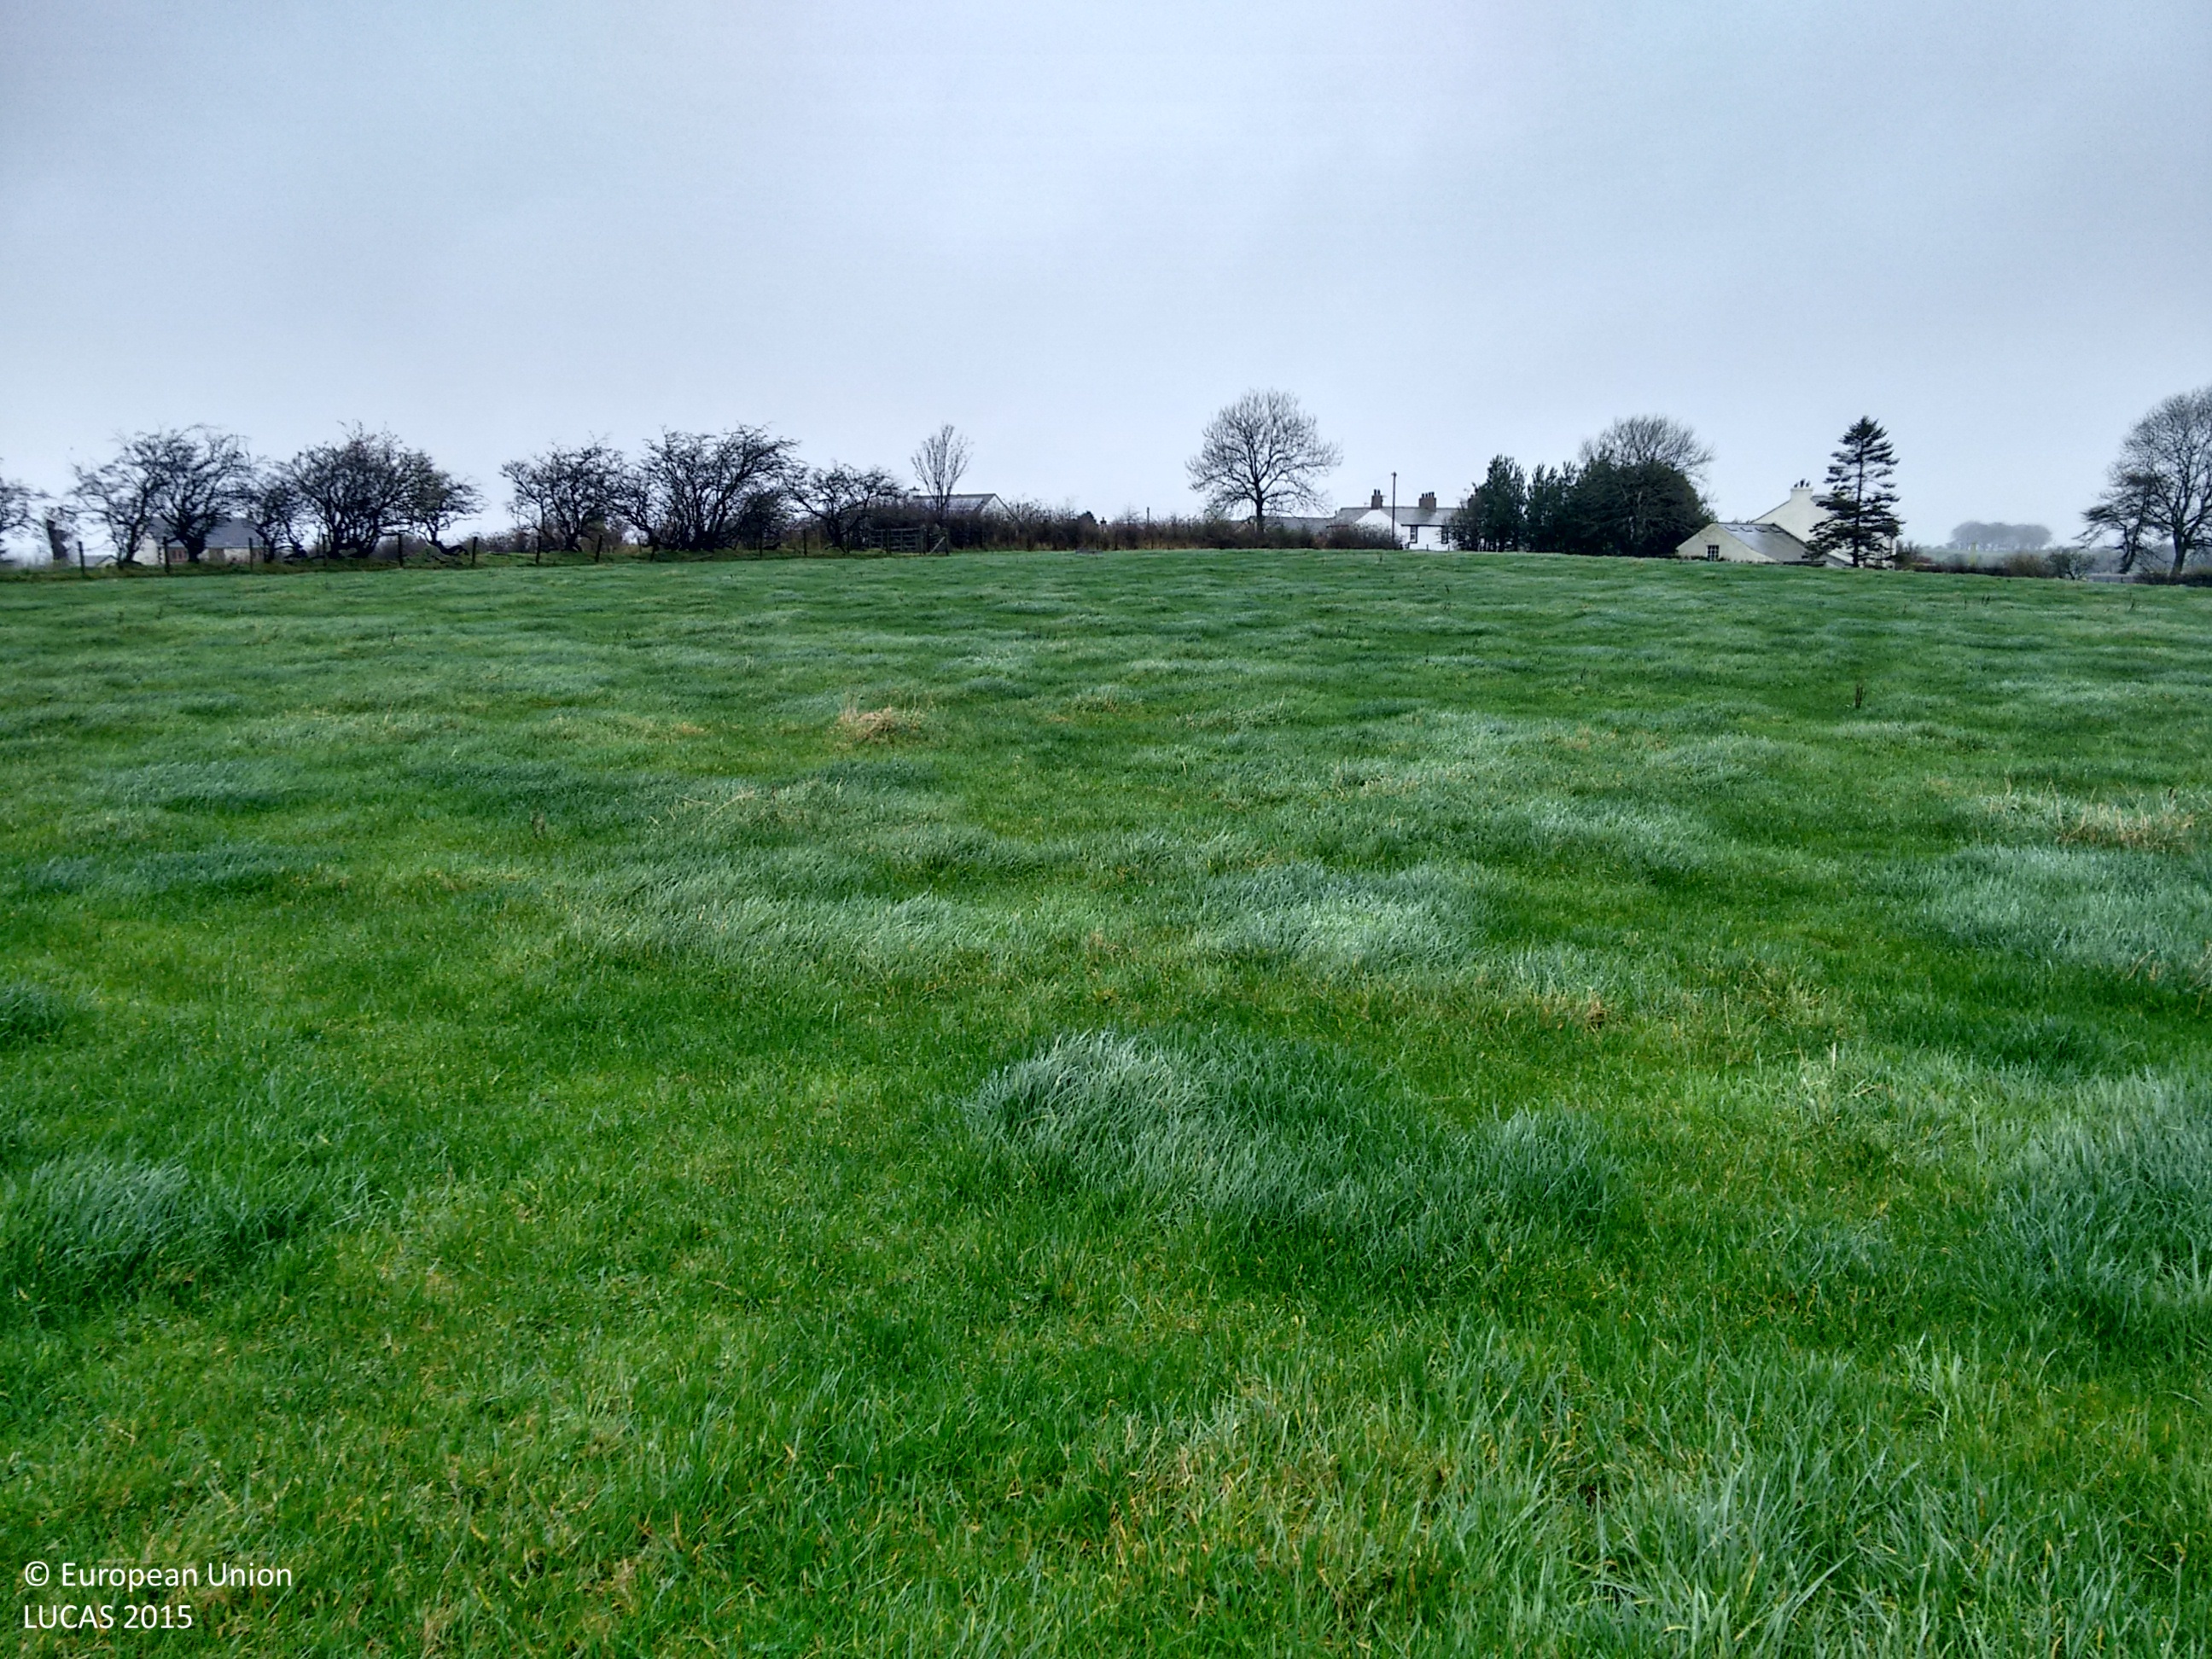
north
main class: Grassland
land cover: Grassland without tree/shrub cover
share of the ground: > 75 %
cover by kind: herbaceous plants 100 %
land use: Agriculture (excluding fallow land and kitchen gardens)
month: November
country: GB
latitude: 54.5651
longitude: -3.4275
